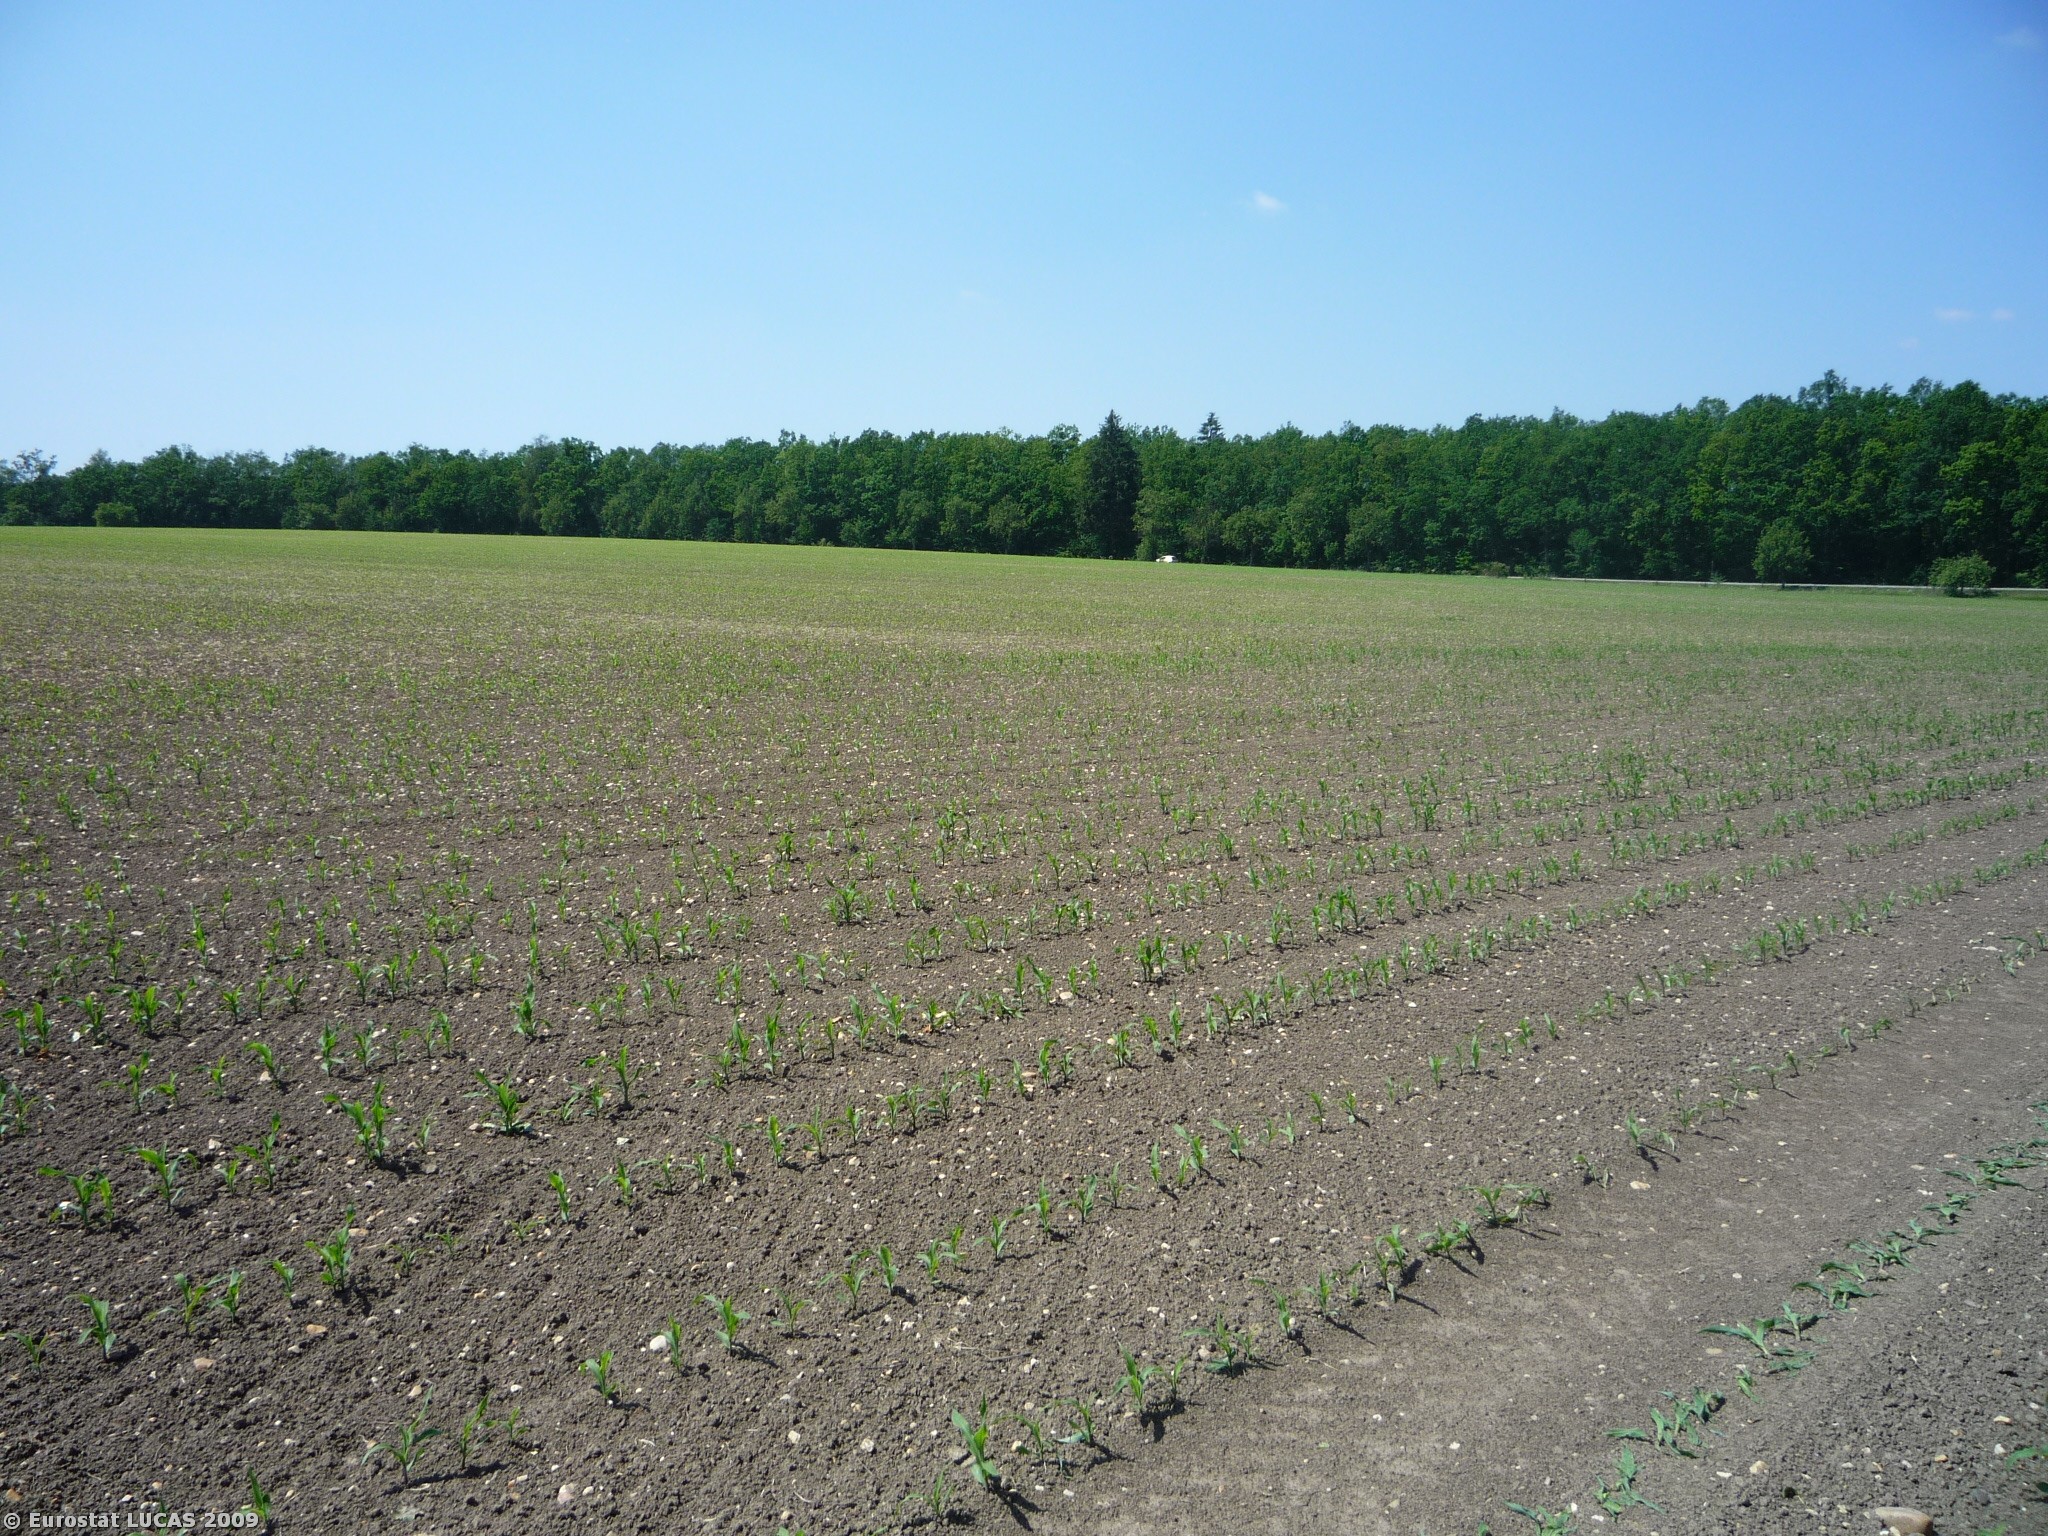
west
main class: Cropland
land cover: Maize
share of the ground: 10 - 25 %
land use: Agriculture (excluding fallow land and kitchen gardens)
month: May
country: CZ
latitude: 50.2835
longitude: 15.5477
